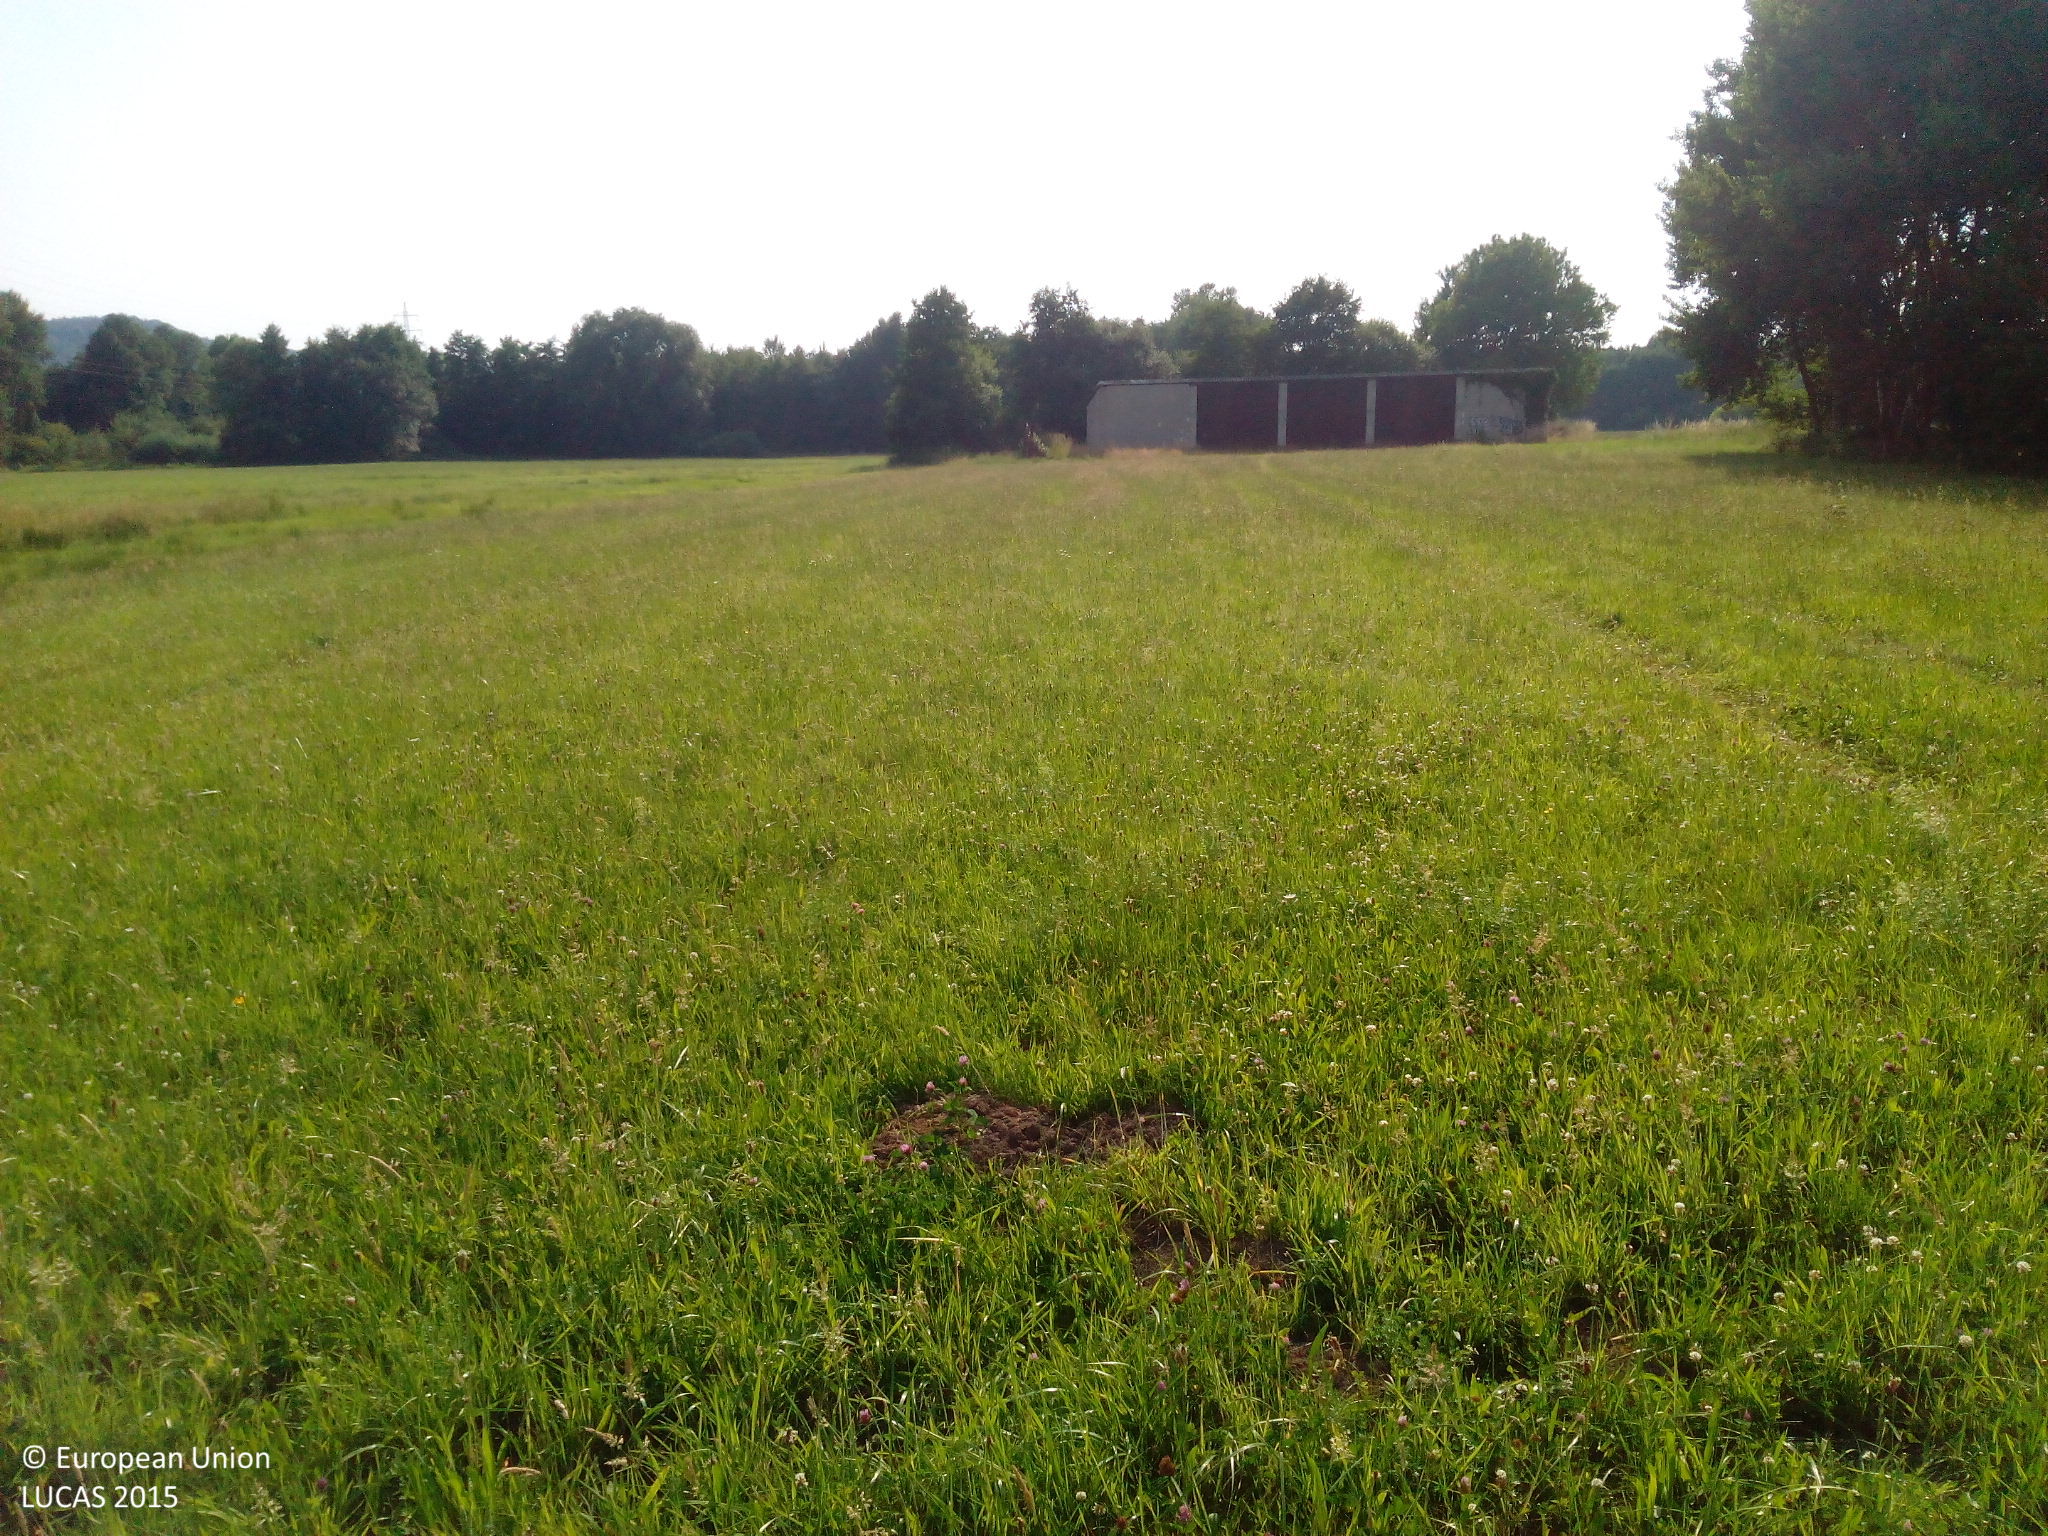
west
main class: Grassland
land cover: Grassland without tree/shrub cover
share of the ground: > 75 %
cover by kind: herbaceous plants 90 %, unconsolidated bare surface 10 %
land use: Agriculture (excluding fallow land and kitchen gardens)
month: July
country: DE
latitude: 49.4205
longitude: 7.5604
